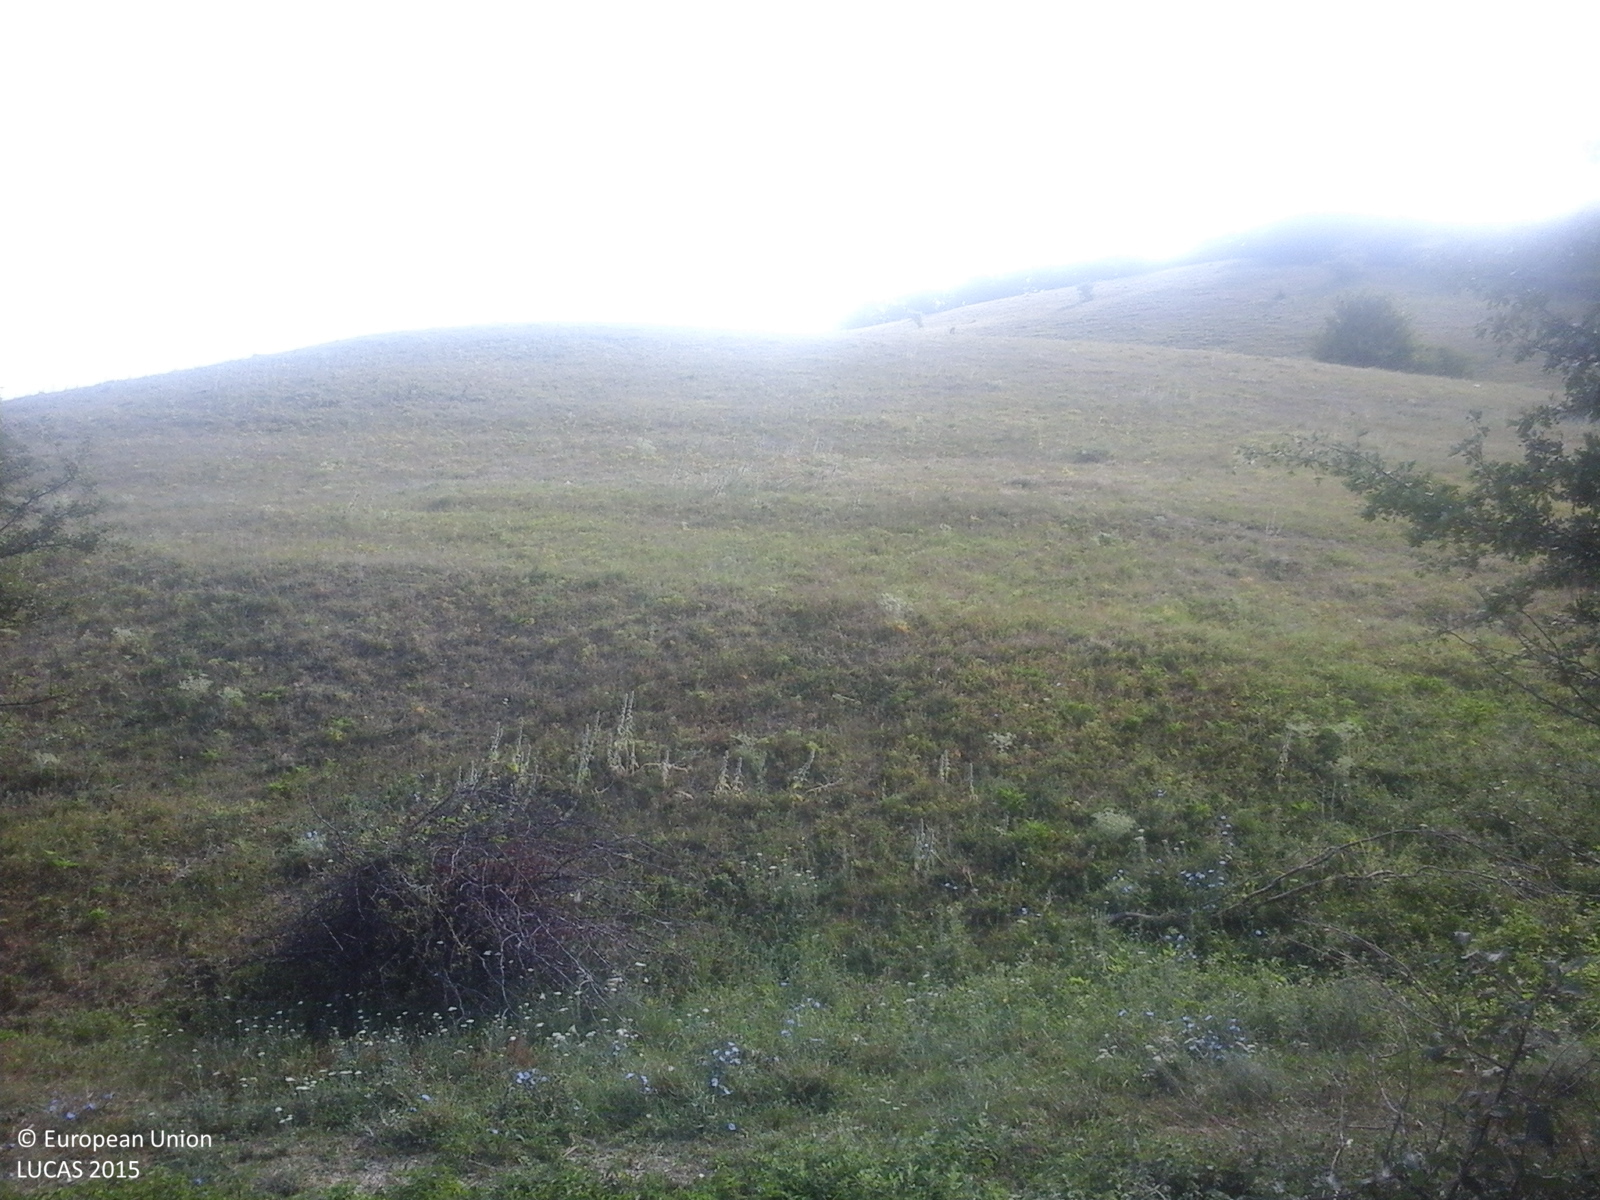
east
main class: Grassland
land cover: Grassland with sparse tree/shrub cover
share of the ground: > 75 %
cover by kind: herbaceous plants 85 %, shrubs 10 %, broadleaved forest trees 5 %
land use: Agriculture (excluding fallow land and kitchen gardens)
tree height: < 5 m
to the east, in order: Grassland with sparse tree/shrub cover; Tracks; Grassland without tree/shrub cover; Tracks; Grassland without tree/shrub cover; Broadleaved woodland
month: July
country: RO
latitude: 46.6053
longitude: 27.9462
